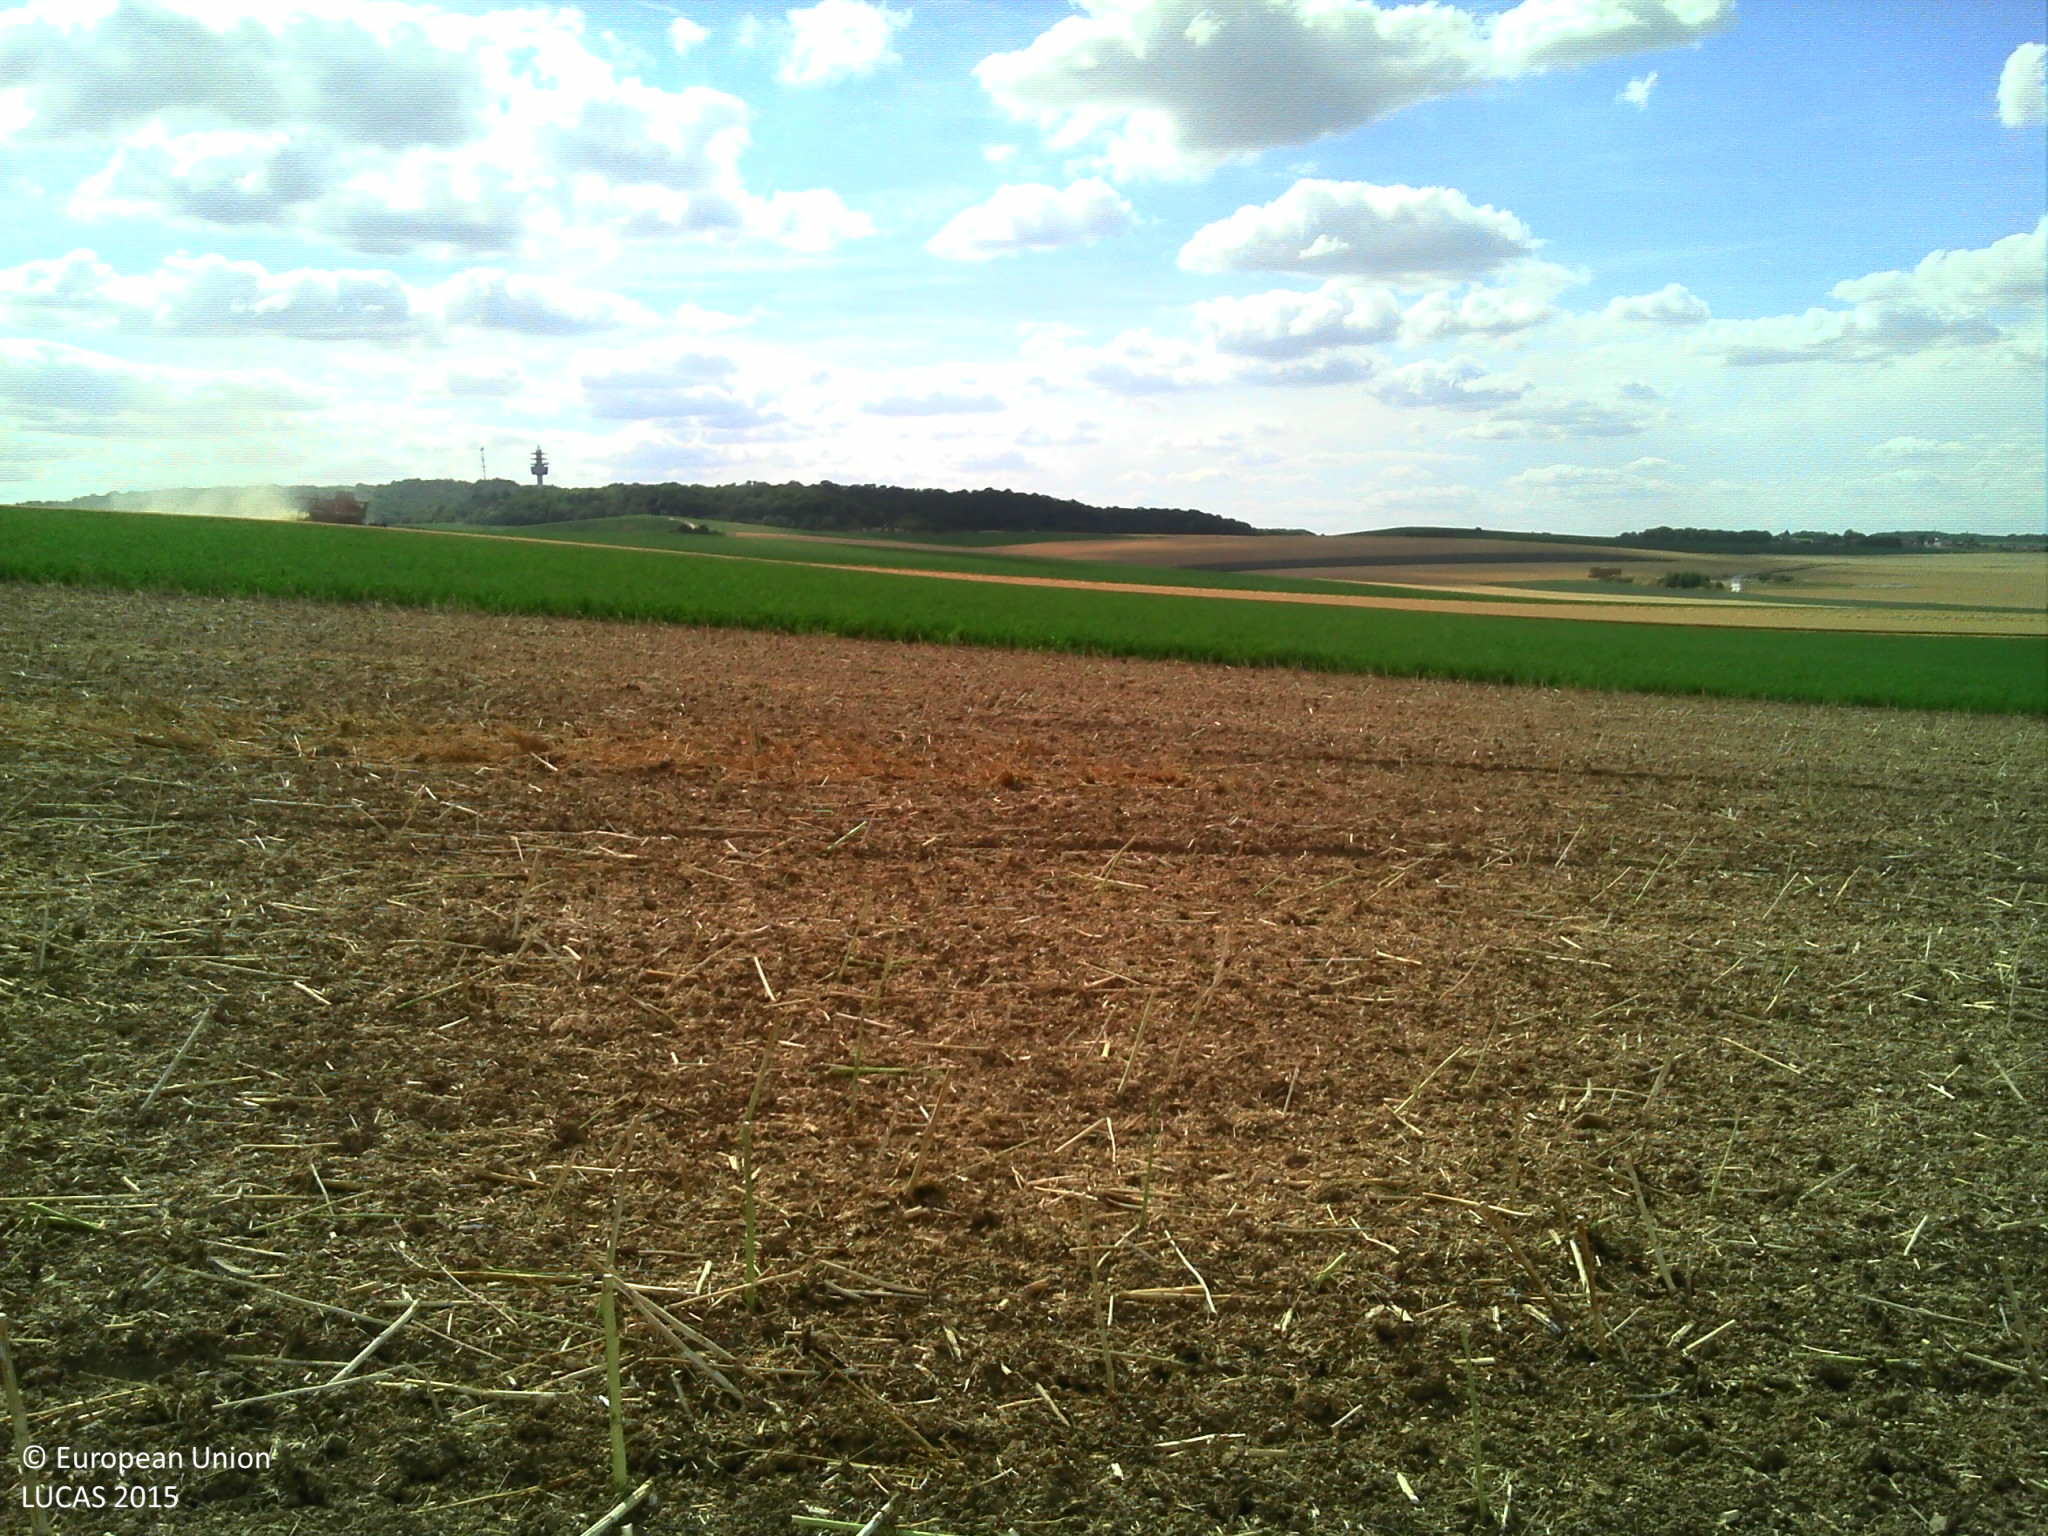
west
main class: Cropland
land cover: Rape and turnip rape
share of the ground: > 75 %
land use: Agriculture (excluding fallow land and kitchen gardens)
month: July
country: FR
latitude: 49.2604
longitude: 4.1831
